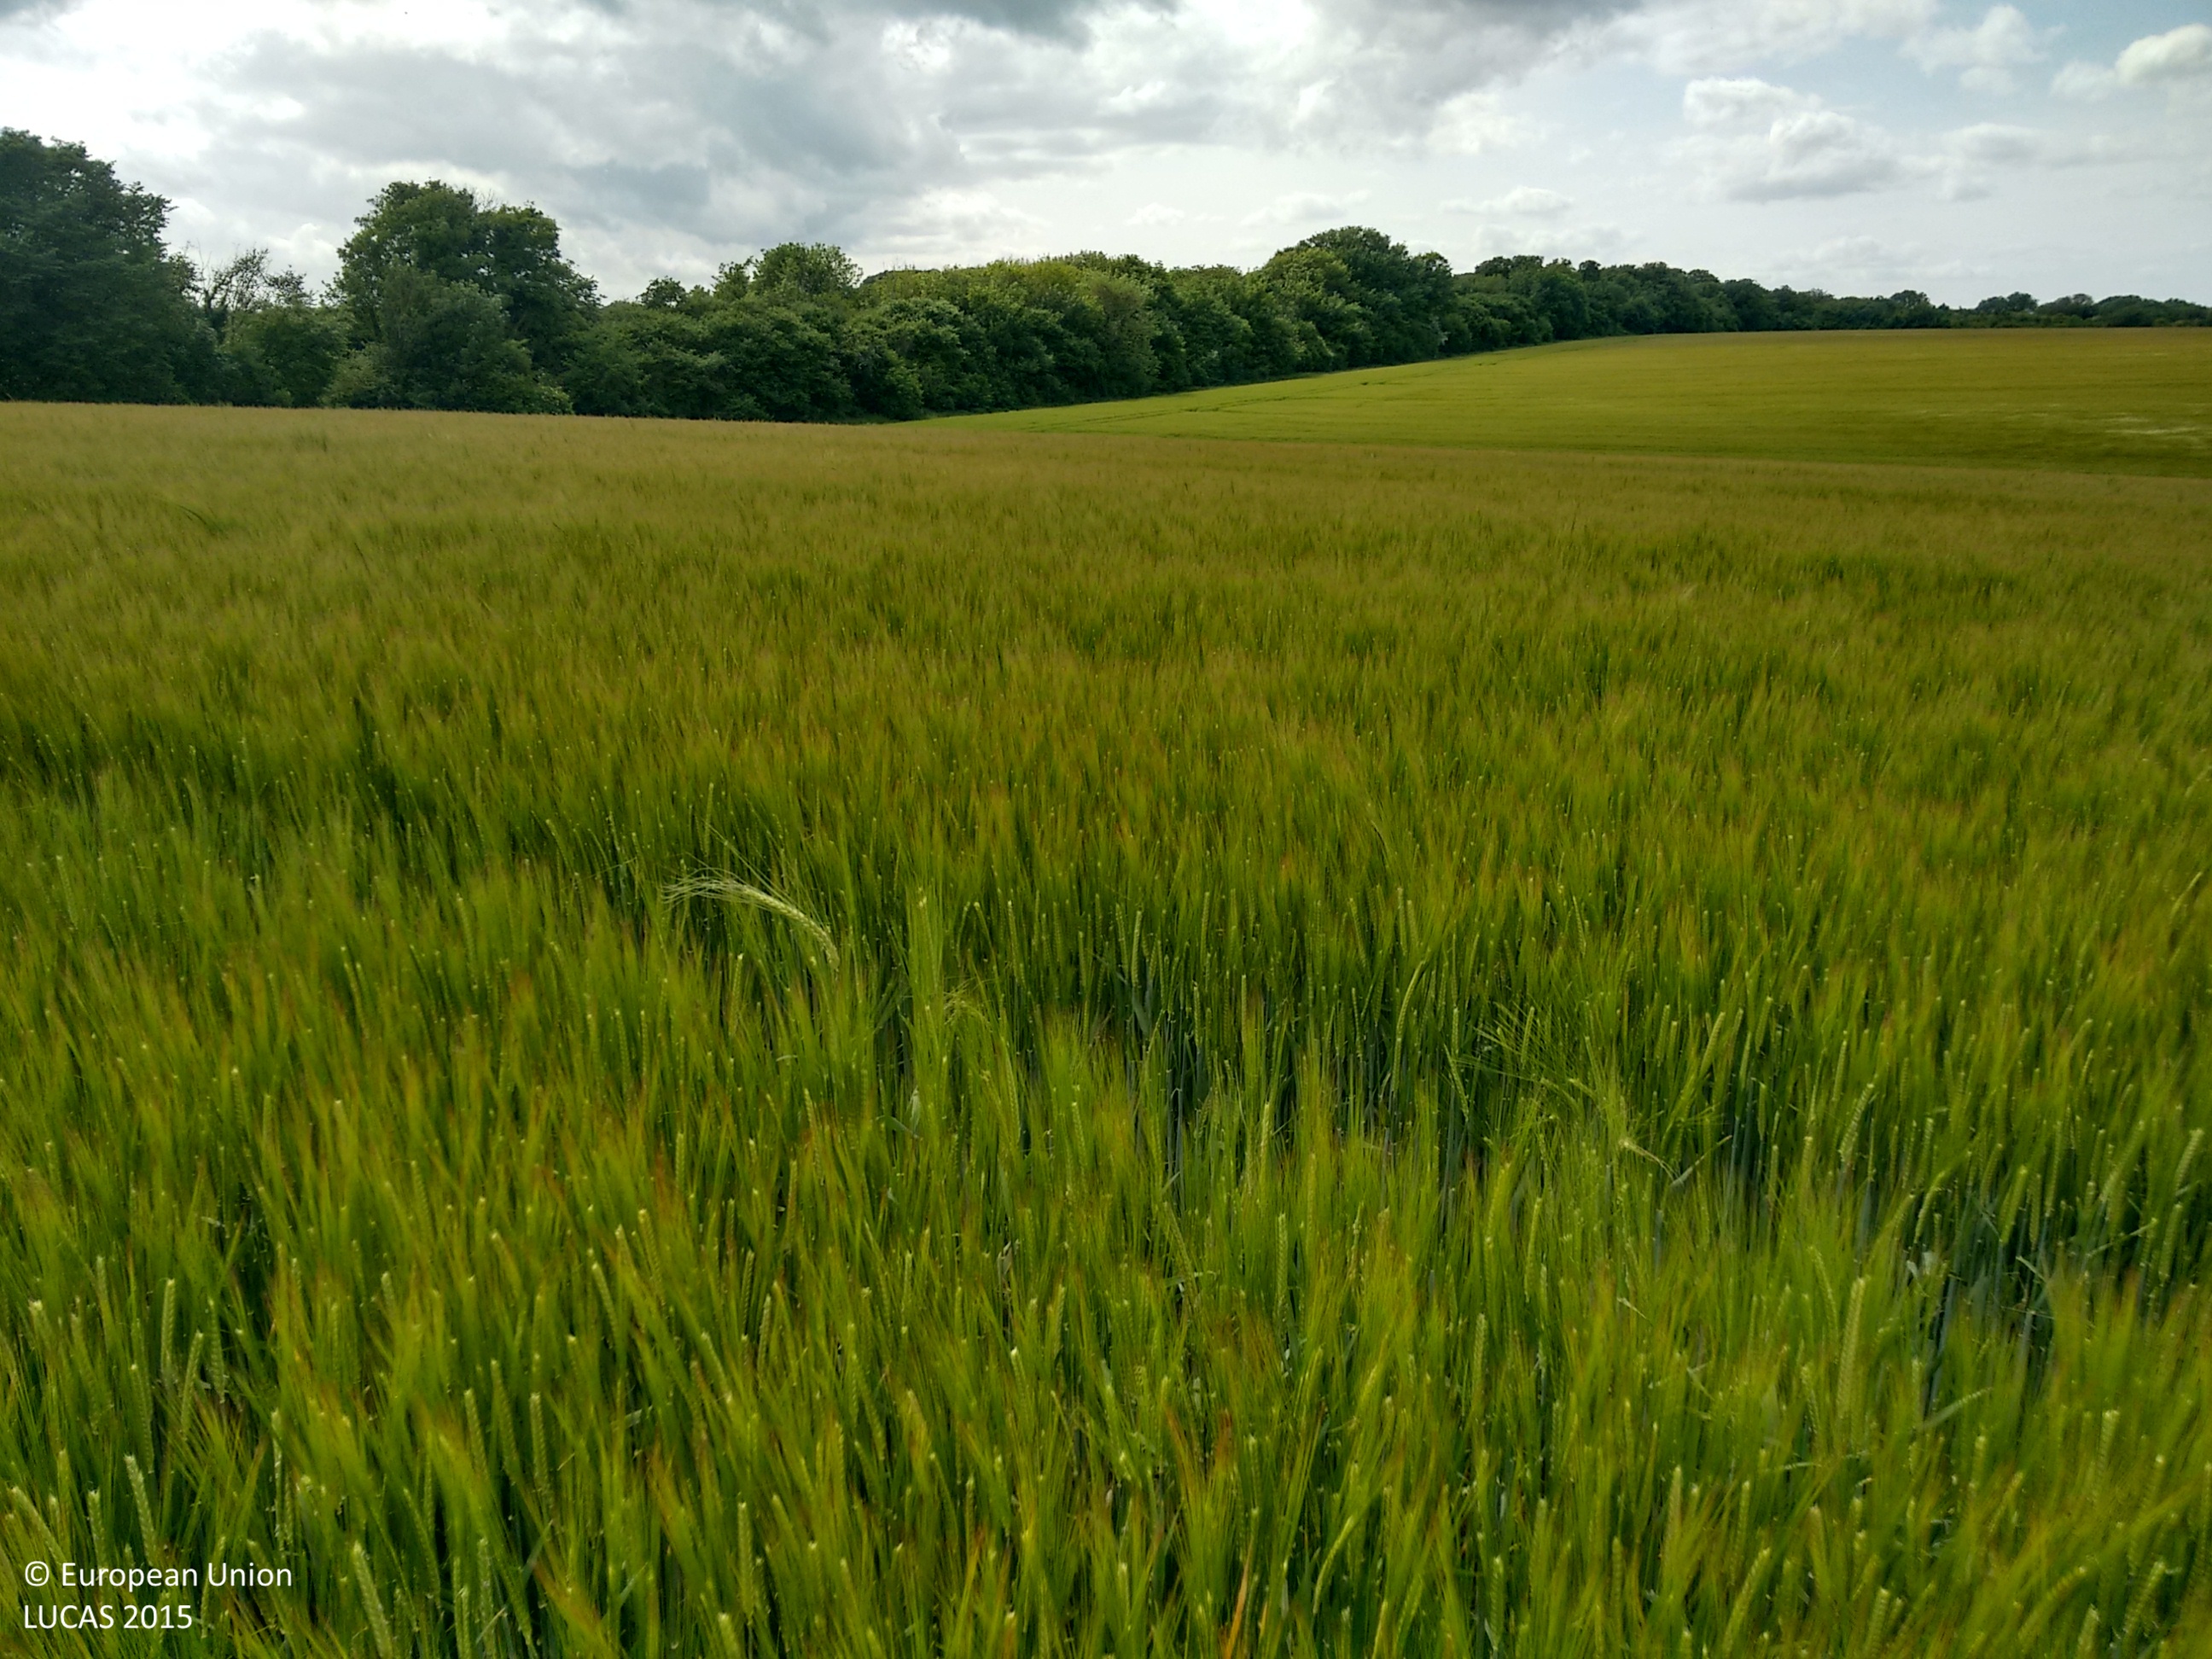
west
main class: Cropland
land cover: Barley
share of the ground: > 75 %
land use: Agriculture (excluding fallow land and kitchen gardens)
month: May
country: GB
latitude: 50.8328
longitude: -2.0569
